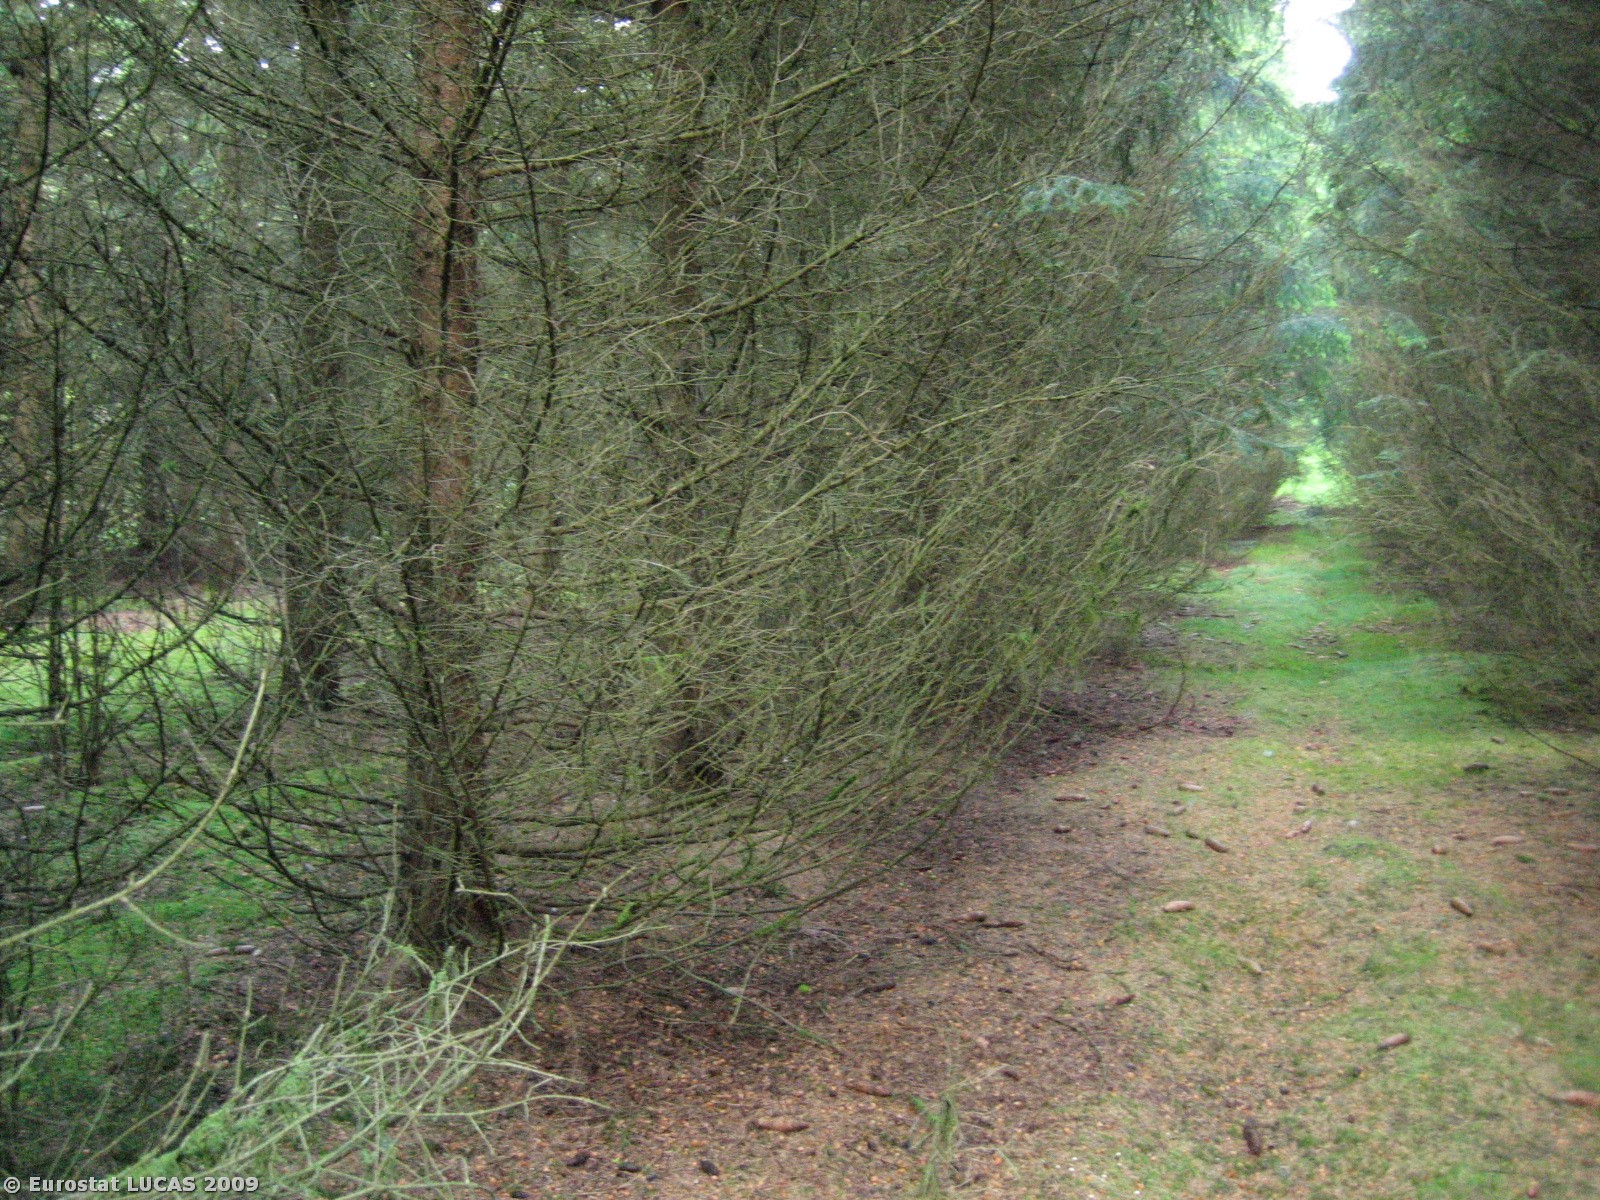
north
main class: Woodland
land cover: Coniferous woodland
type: hemiboreal forest and nemoral coniferous forest and mixed broadleaved-coniferous forest
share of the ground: > 75 %
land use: Forestry
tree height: > 5 m
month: May
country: DK
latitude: 55.8623
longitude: 9.3137
